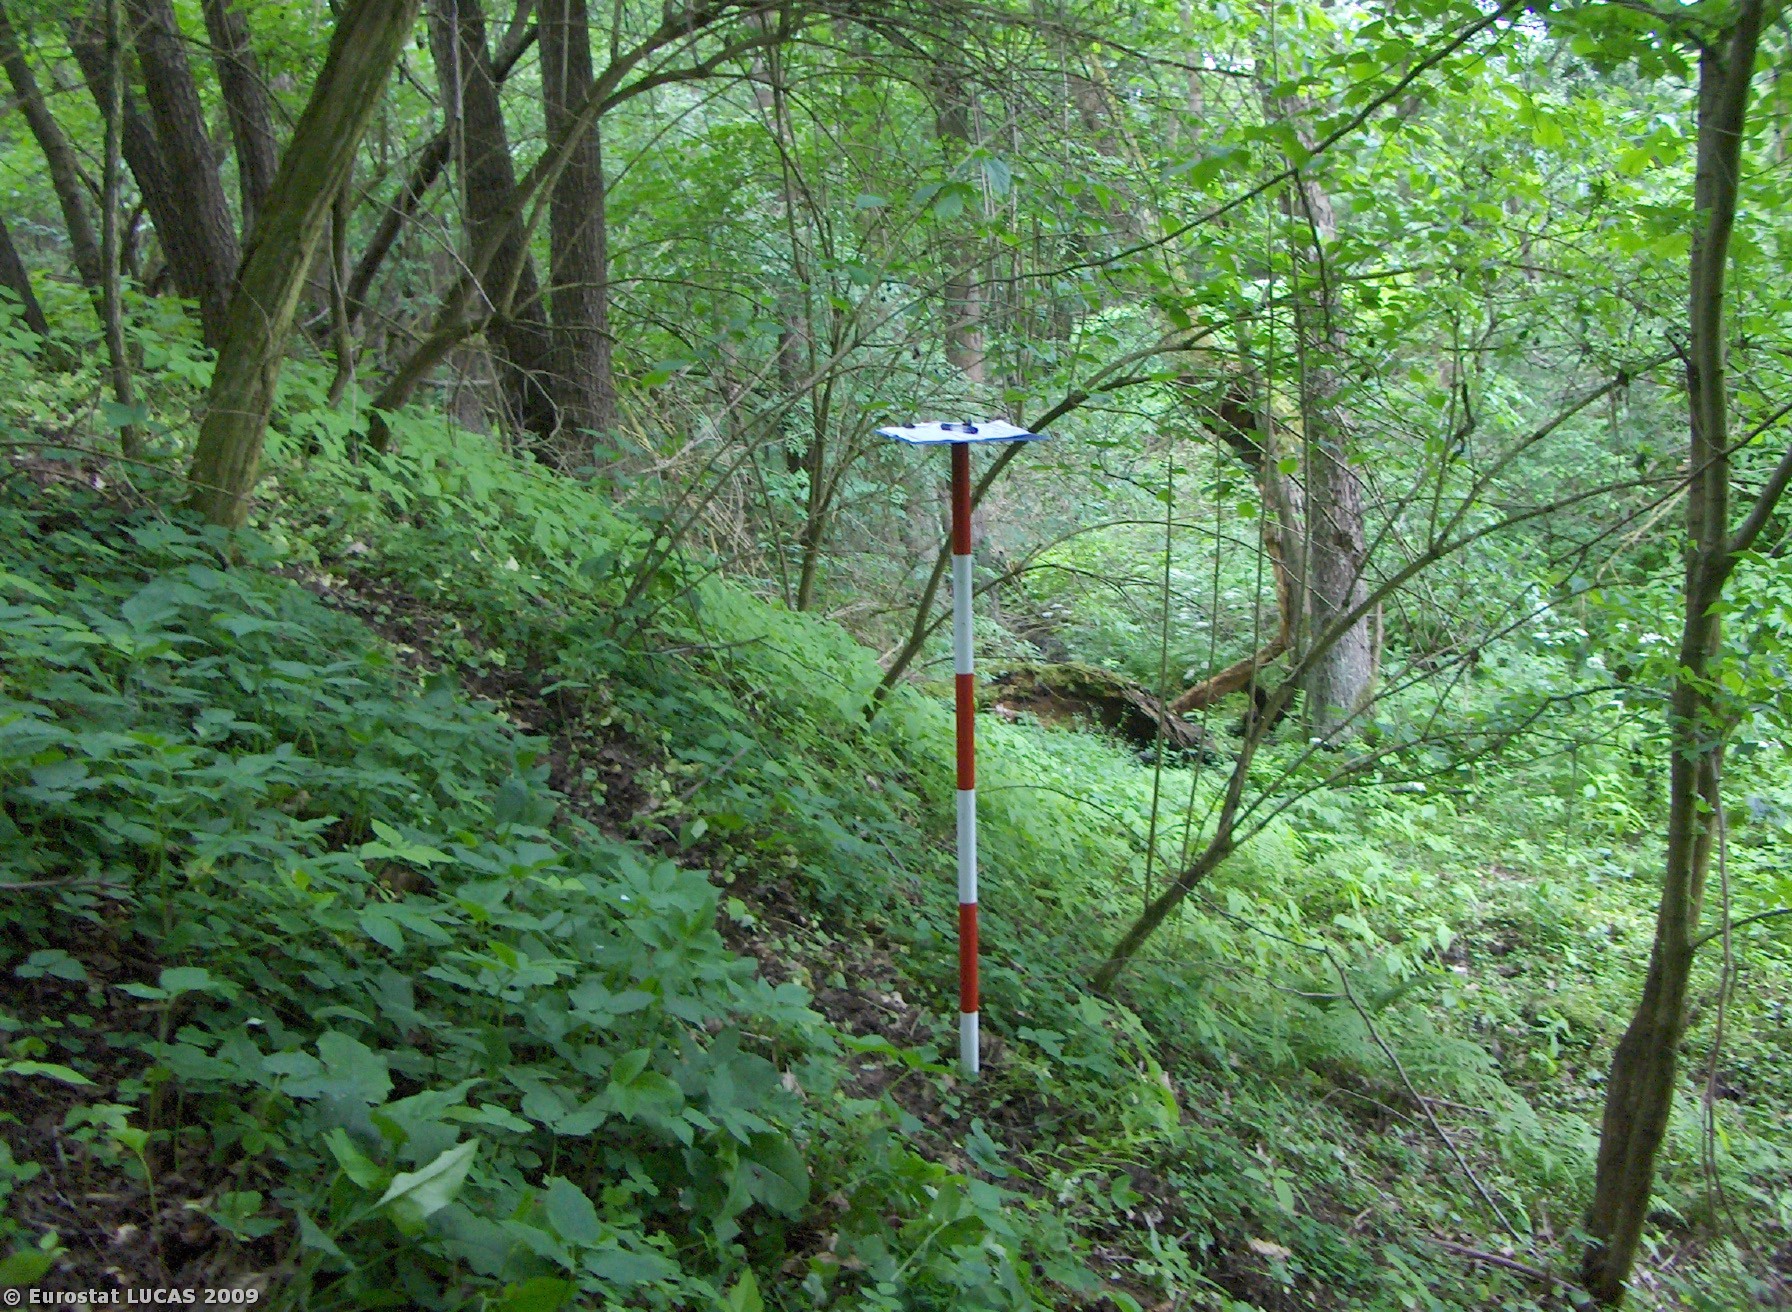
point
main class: Woodland
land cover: Broadleaved woodland
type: mesophytic deciduous forest
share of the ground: > 75 %
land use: Forestry
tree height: > 5 m
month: May
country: CZ
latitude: 49.6146
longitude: 14.3610
